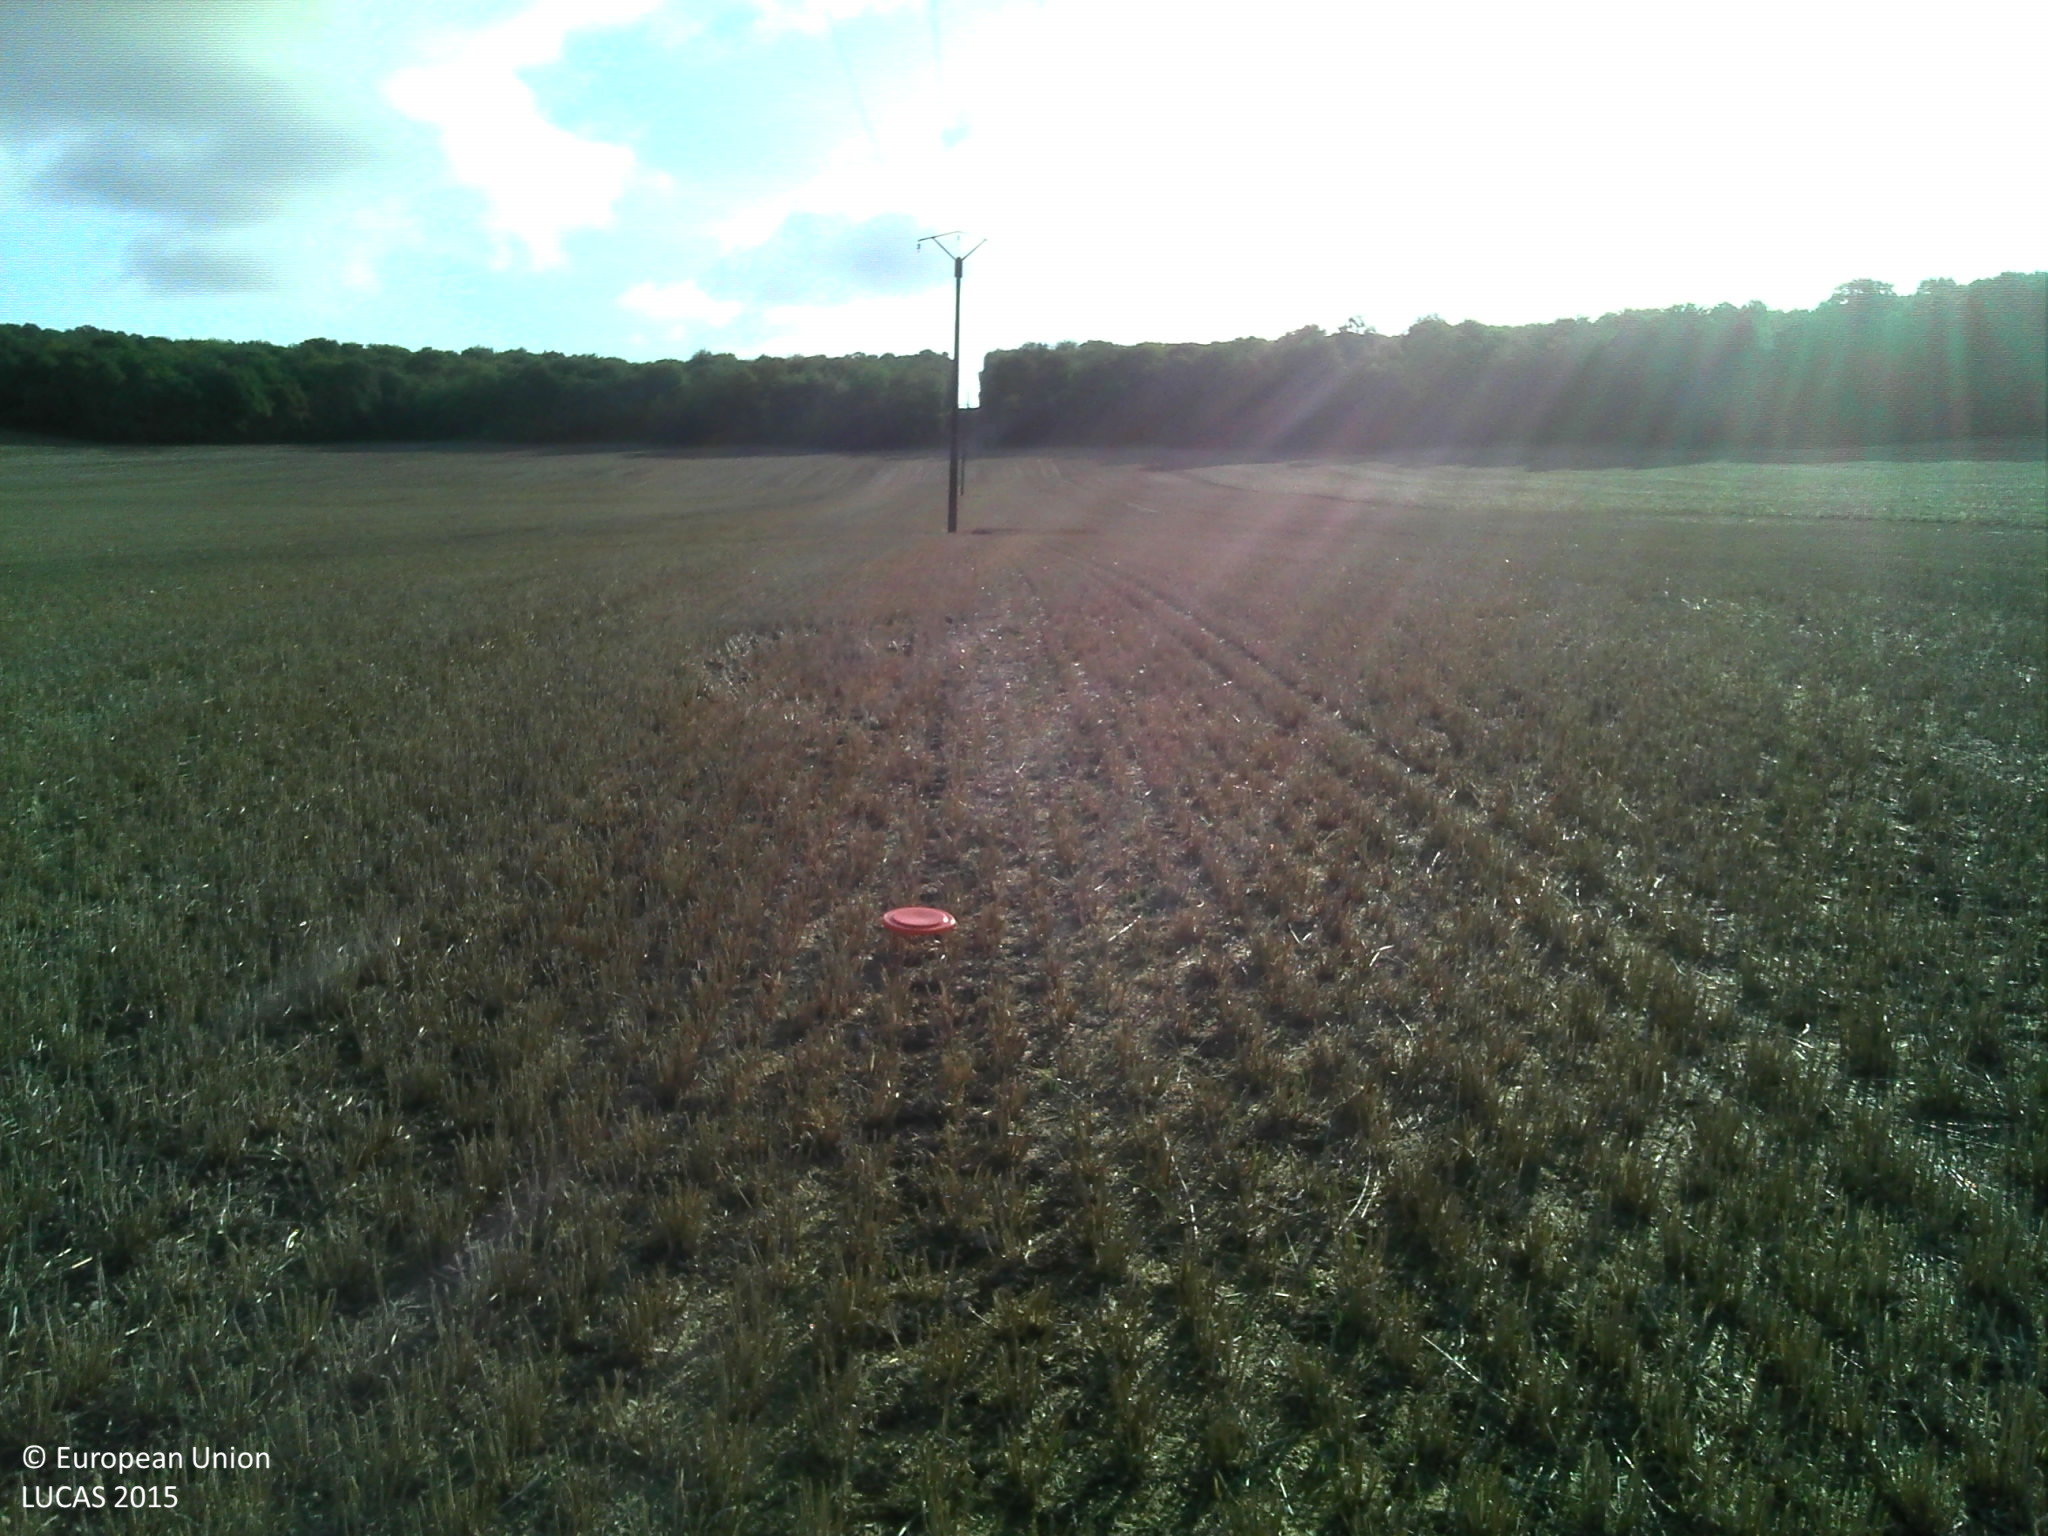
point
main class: Cropland
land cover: Common wheat
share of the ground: > 75 %
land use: Agriculture (excluding fallow land and kitchen gardens)
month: August
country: FR
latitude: 47.8613
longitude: 4.6921
